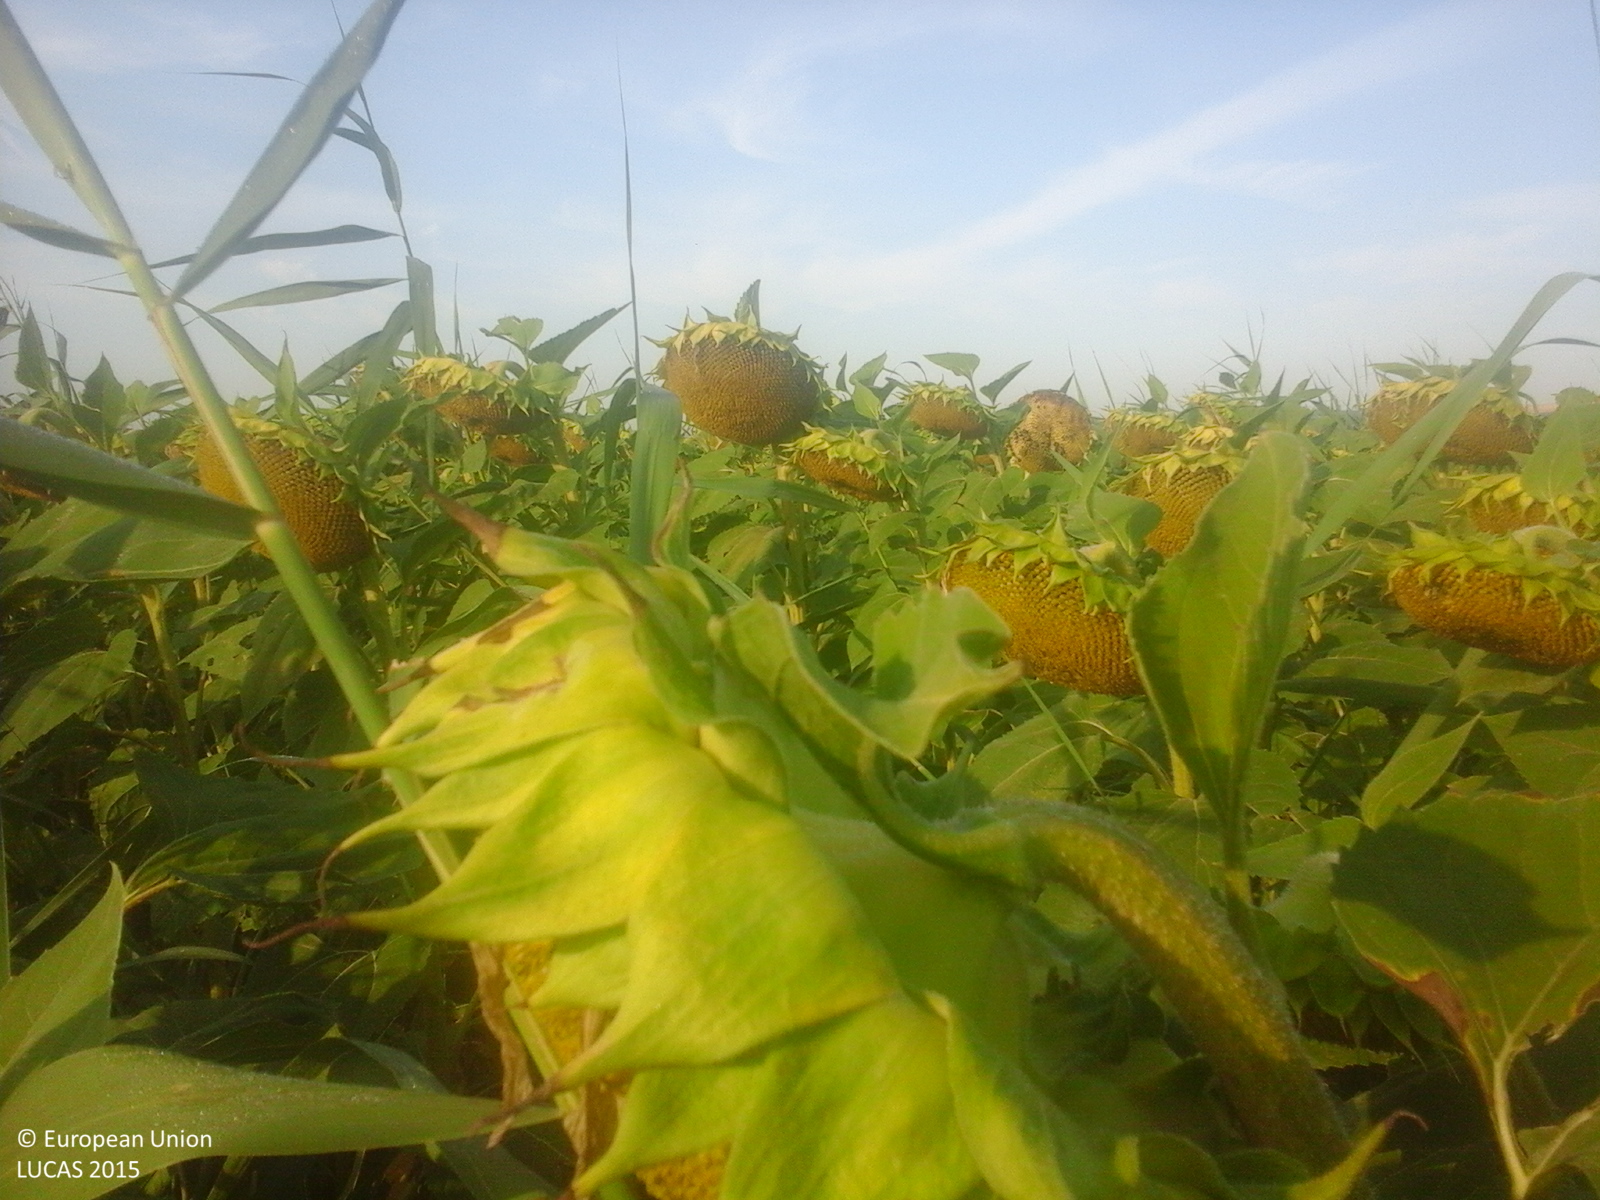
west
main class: Cropland
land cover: Sunflower
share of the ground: > 75 %
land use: Agriculture (excluding fallow land and kitchen gardens)
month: July
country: RO
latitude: 46.7096
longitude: 28.1989
